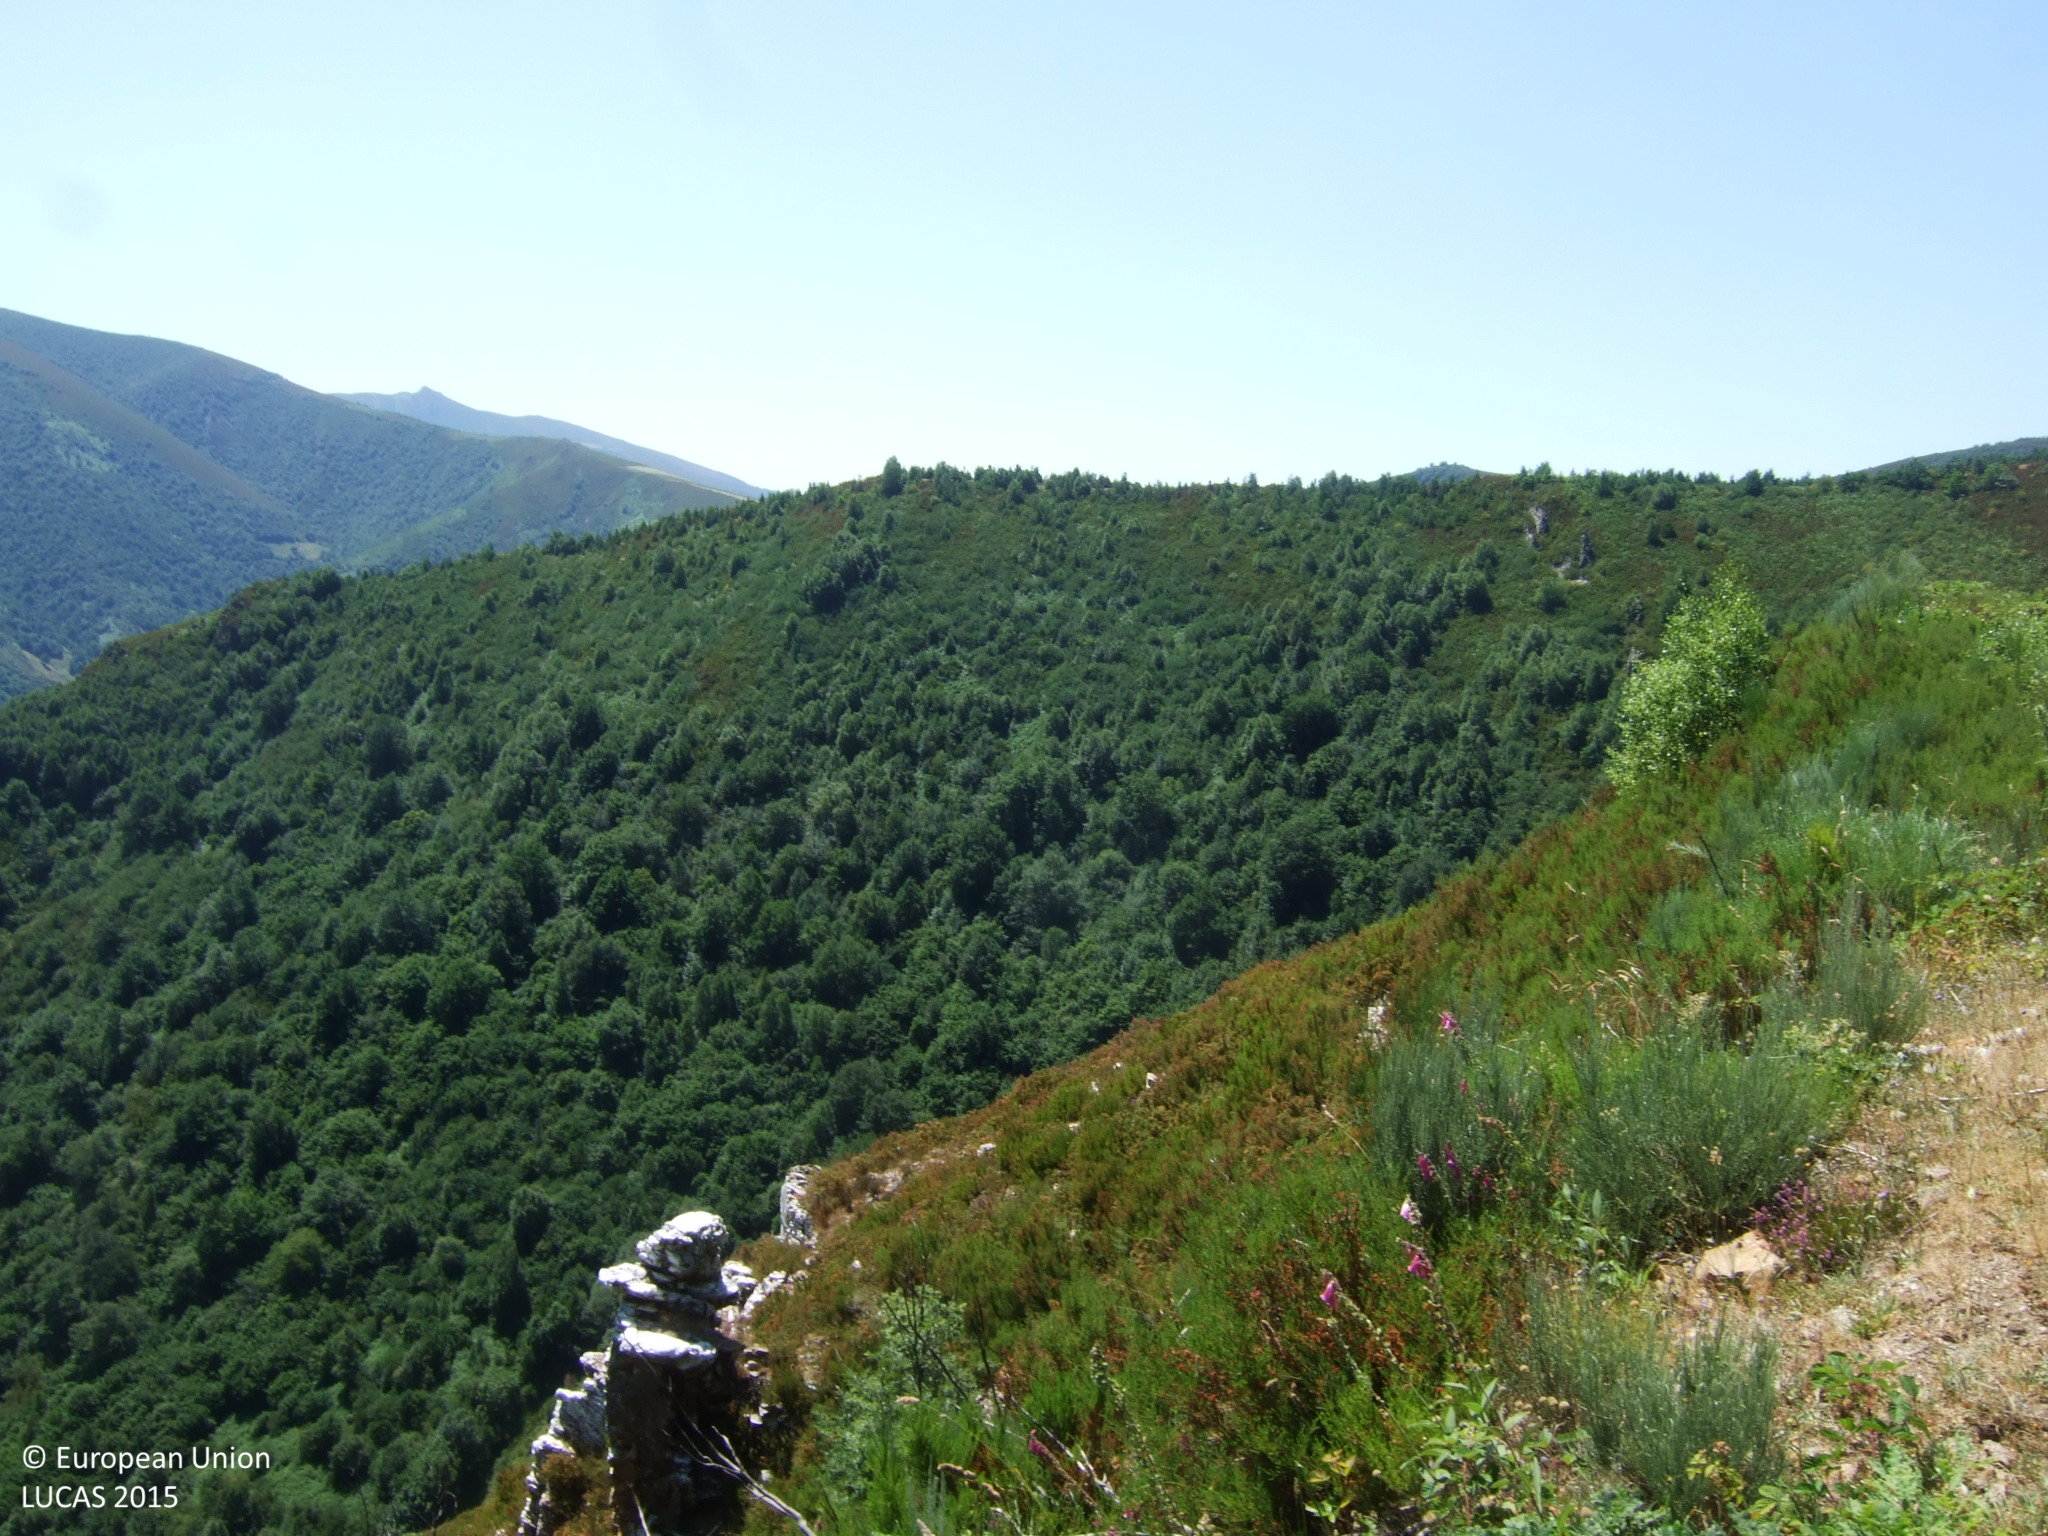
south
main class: Woodland
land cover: Broadleaved woodland
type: acidophilous oak and oak-birch forest
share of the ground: 25 - 50 %
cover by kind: shrubs 75 %, broadleaved forest trees 25 %
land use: Semi-natural and natural areas not in use
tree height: < 5 m
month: June
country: ES
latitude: 42.8542
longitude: -6.9347
